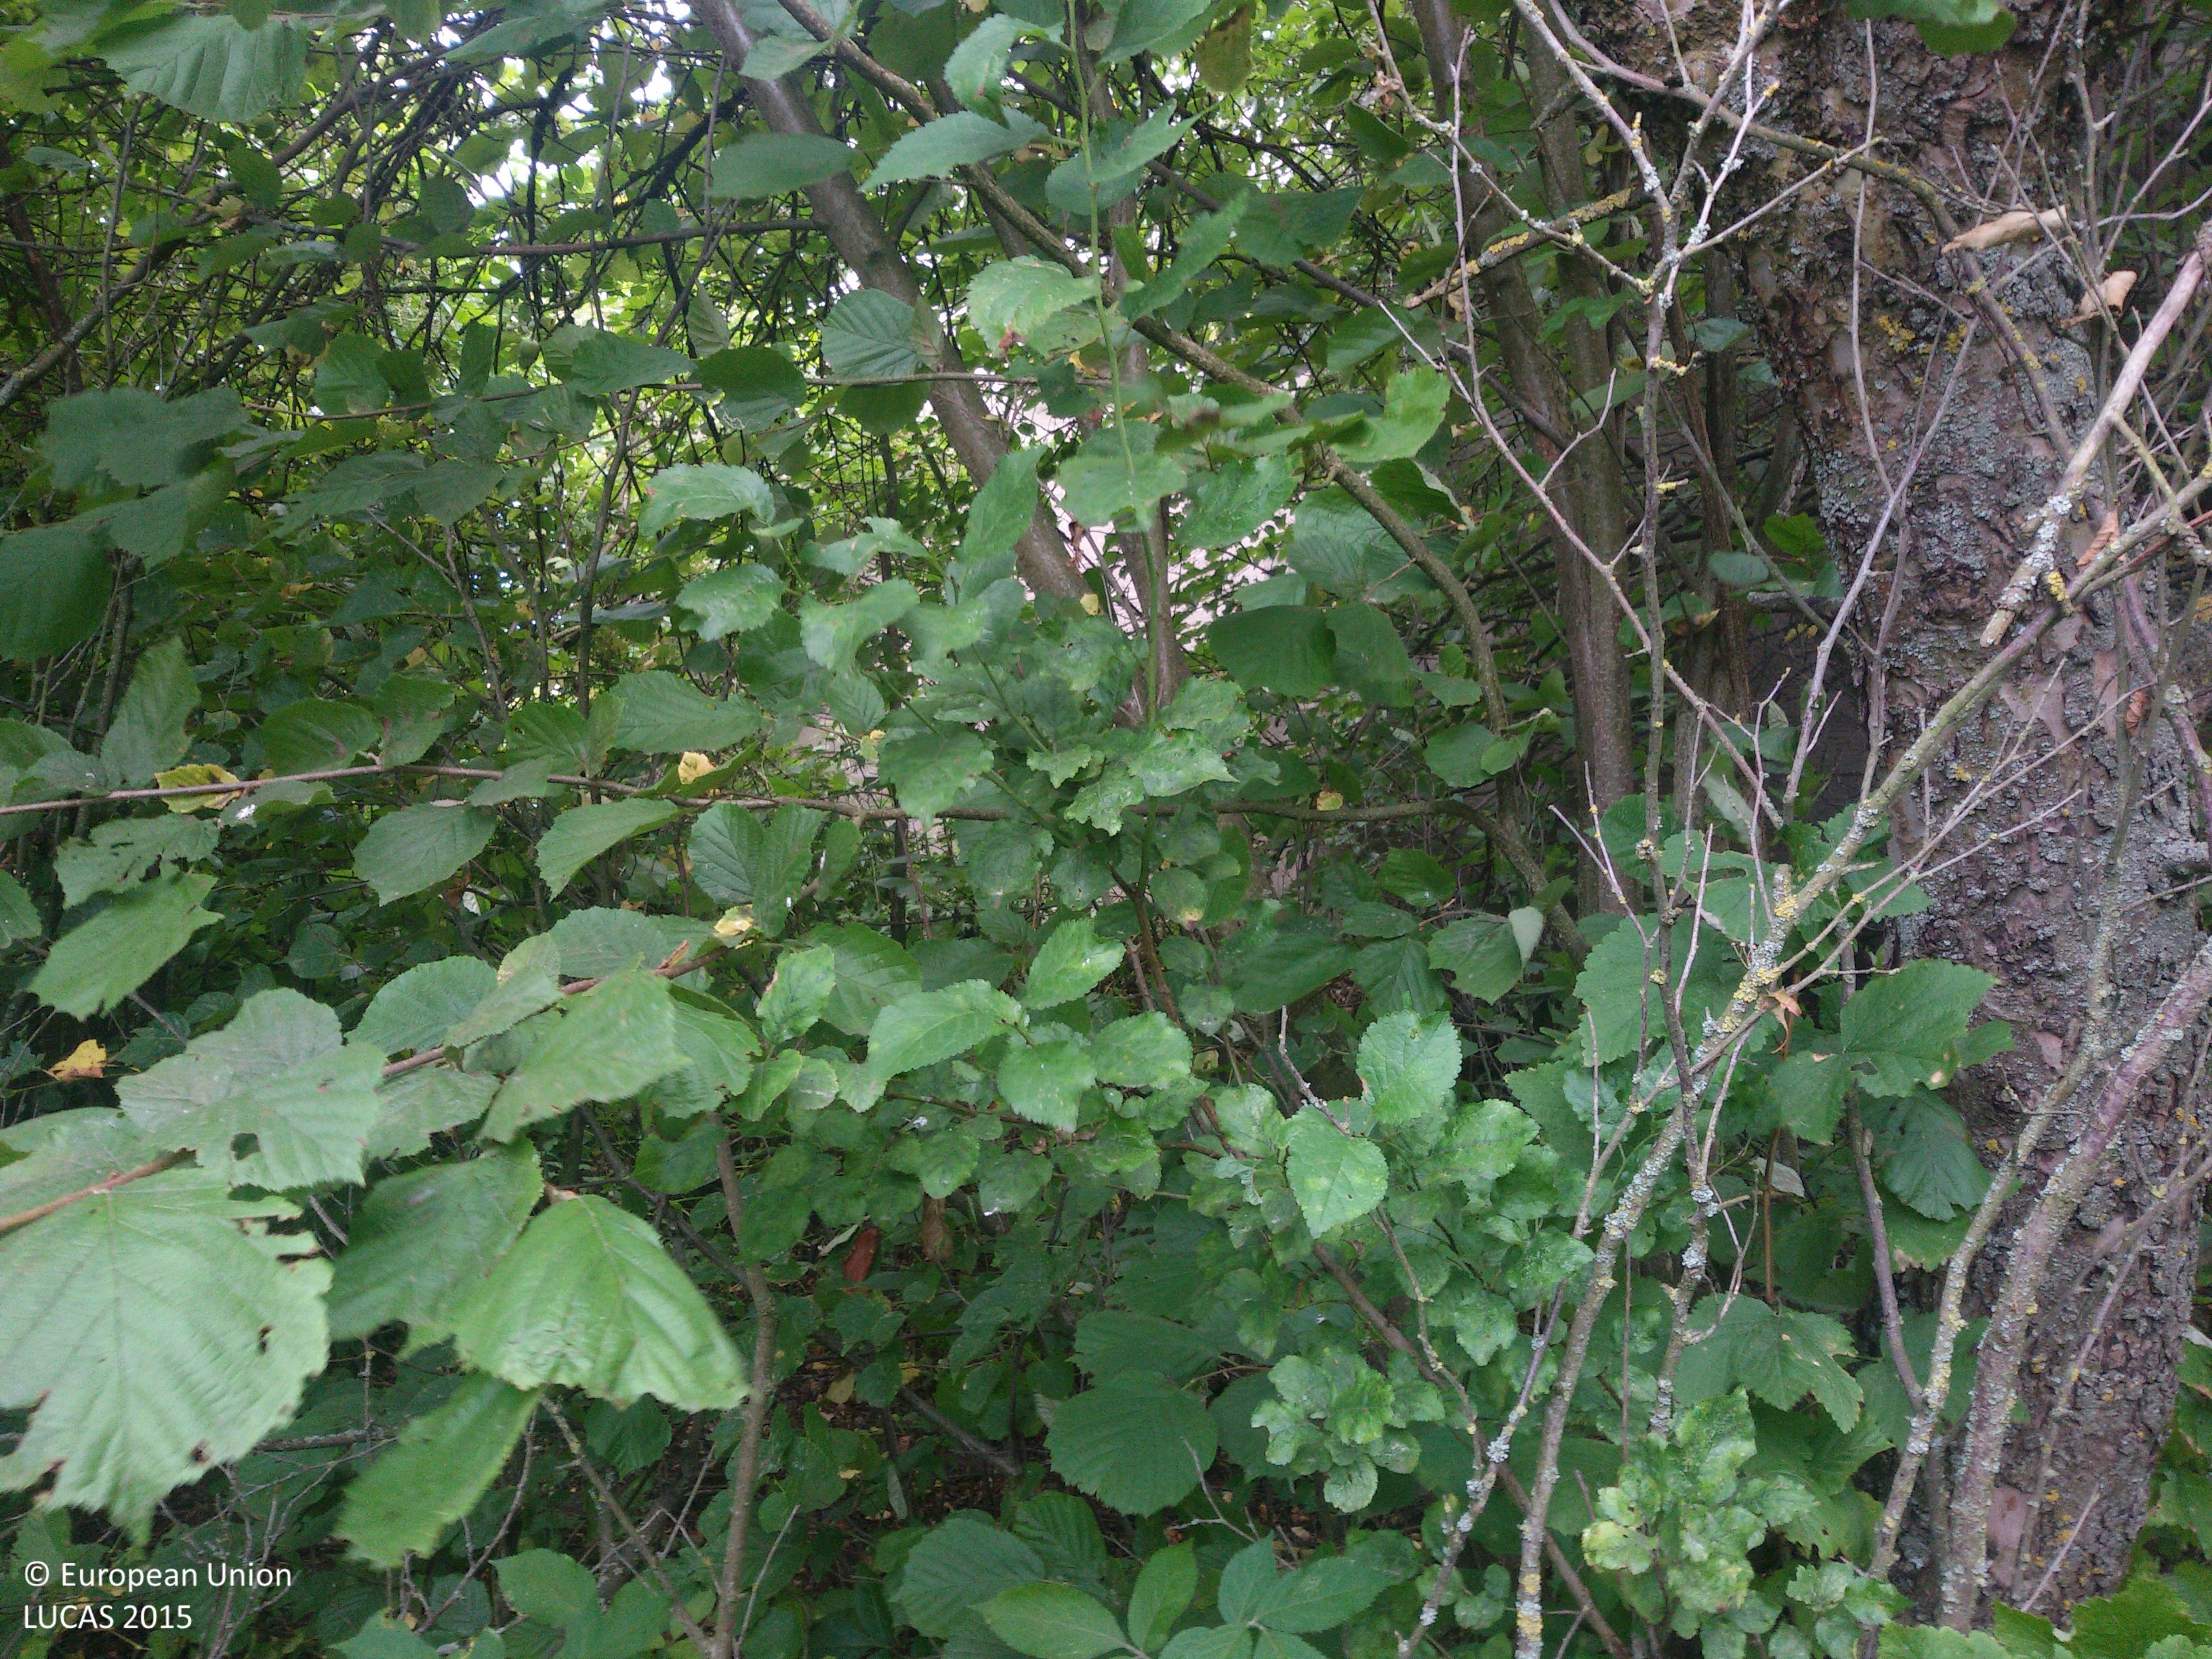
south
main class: Woodland
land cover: Broadleaved woodland
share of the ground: 50 - 75 %
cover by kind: shrubs 65 %, broadleaved forest trees 20 %, herbaceous plants 5 %
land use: Residential
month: July
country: PL
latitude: 53.6732
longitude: 23.5721
